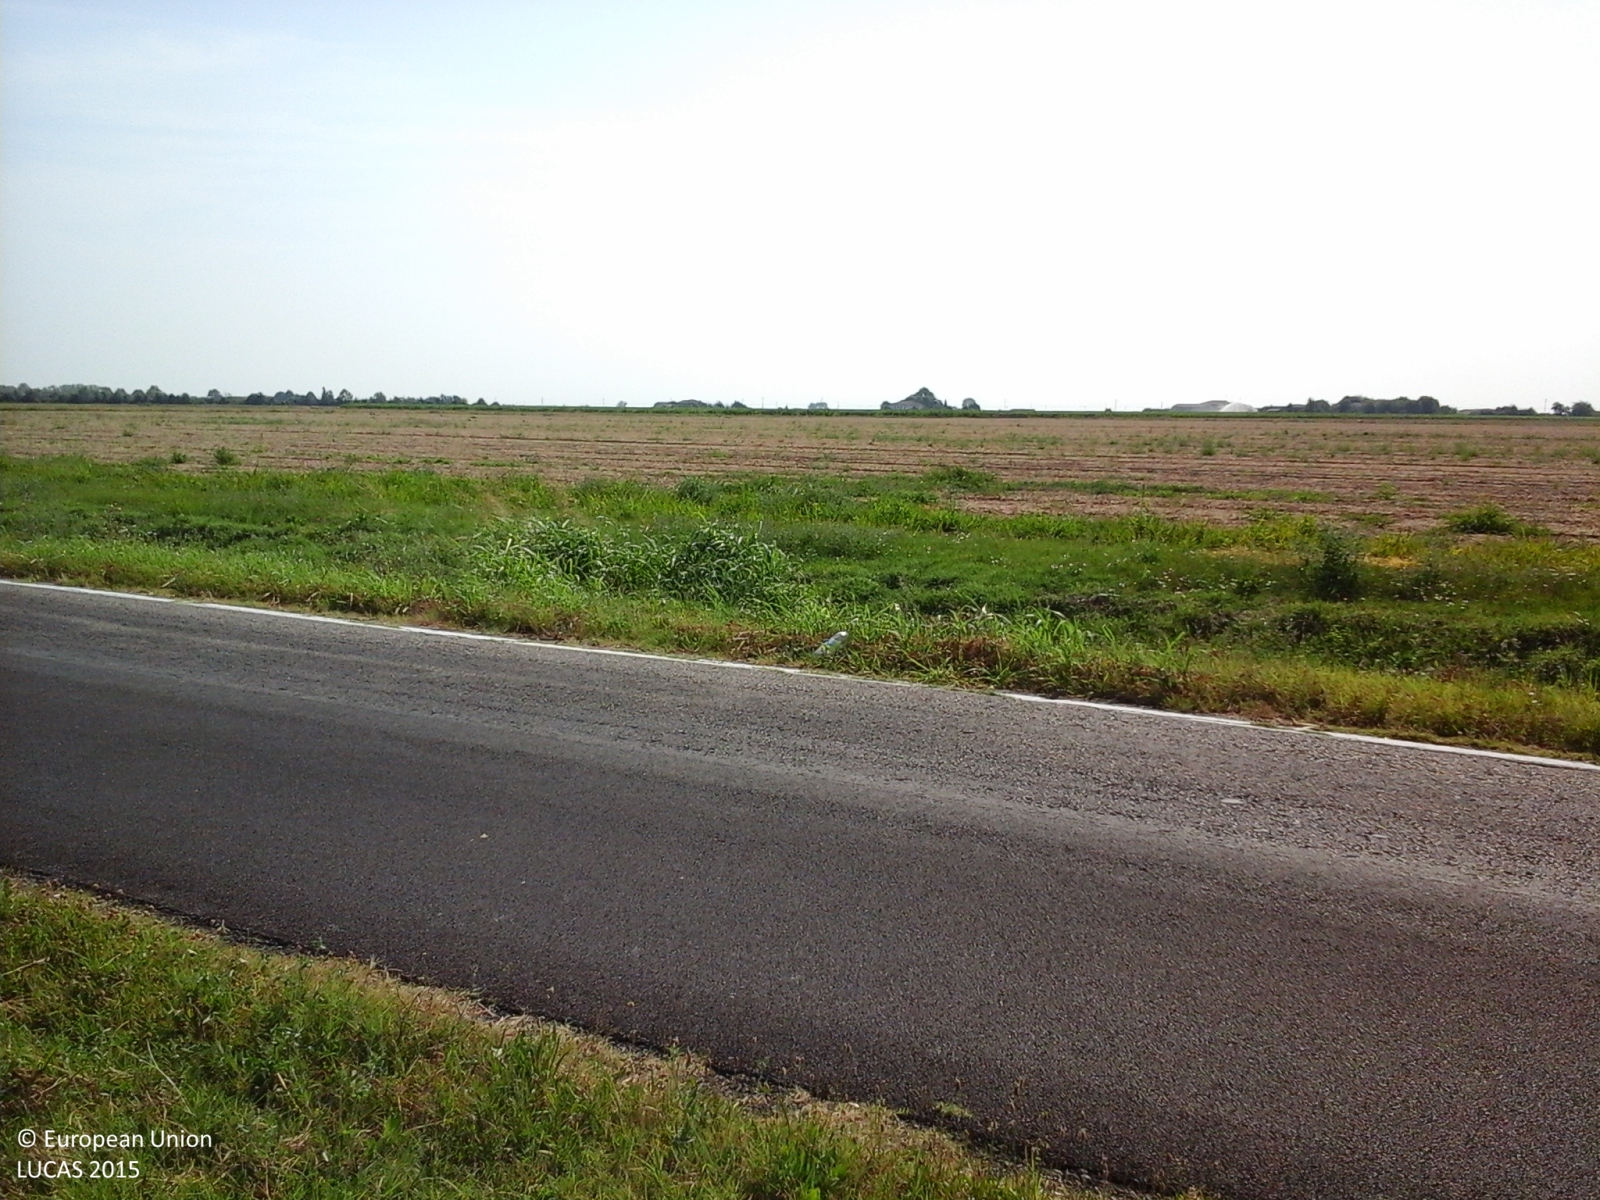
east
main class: Cropland
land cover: Sugar beet
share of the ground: > 75 %
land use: Agriculture (excluding fallow land and kitchen gardens)
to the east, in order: Sugar beet; Electric lines; Grass margins; Ditches and canals; Grass margins; Tracks; Grass margins; Ditches and canals; Grass margins; Dry pulses; Ditches and canals; Dry pulses; Ditches and canals; Dry pulses; Ditches and canals; Dry pulses
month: July
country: IT
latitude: 44.4999
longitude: 11.6440
